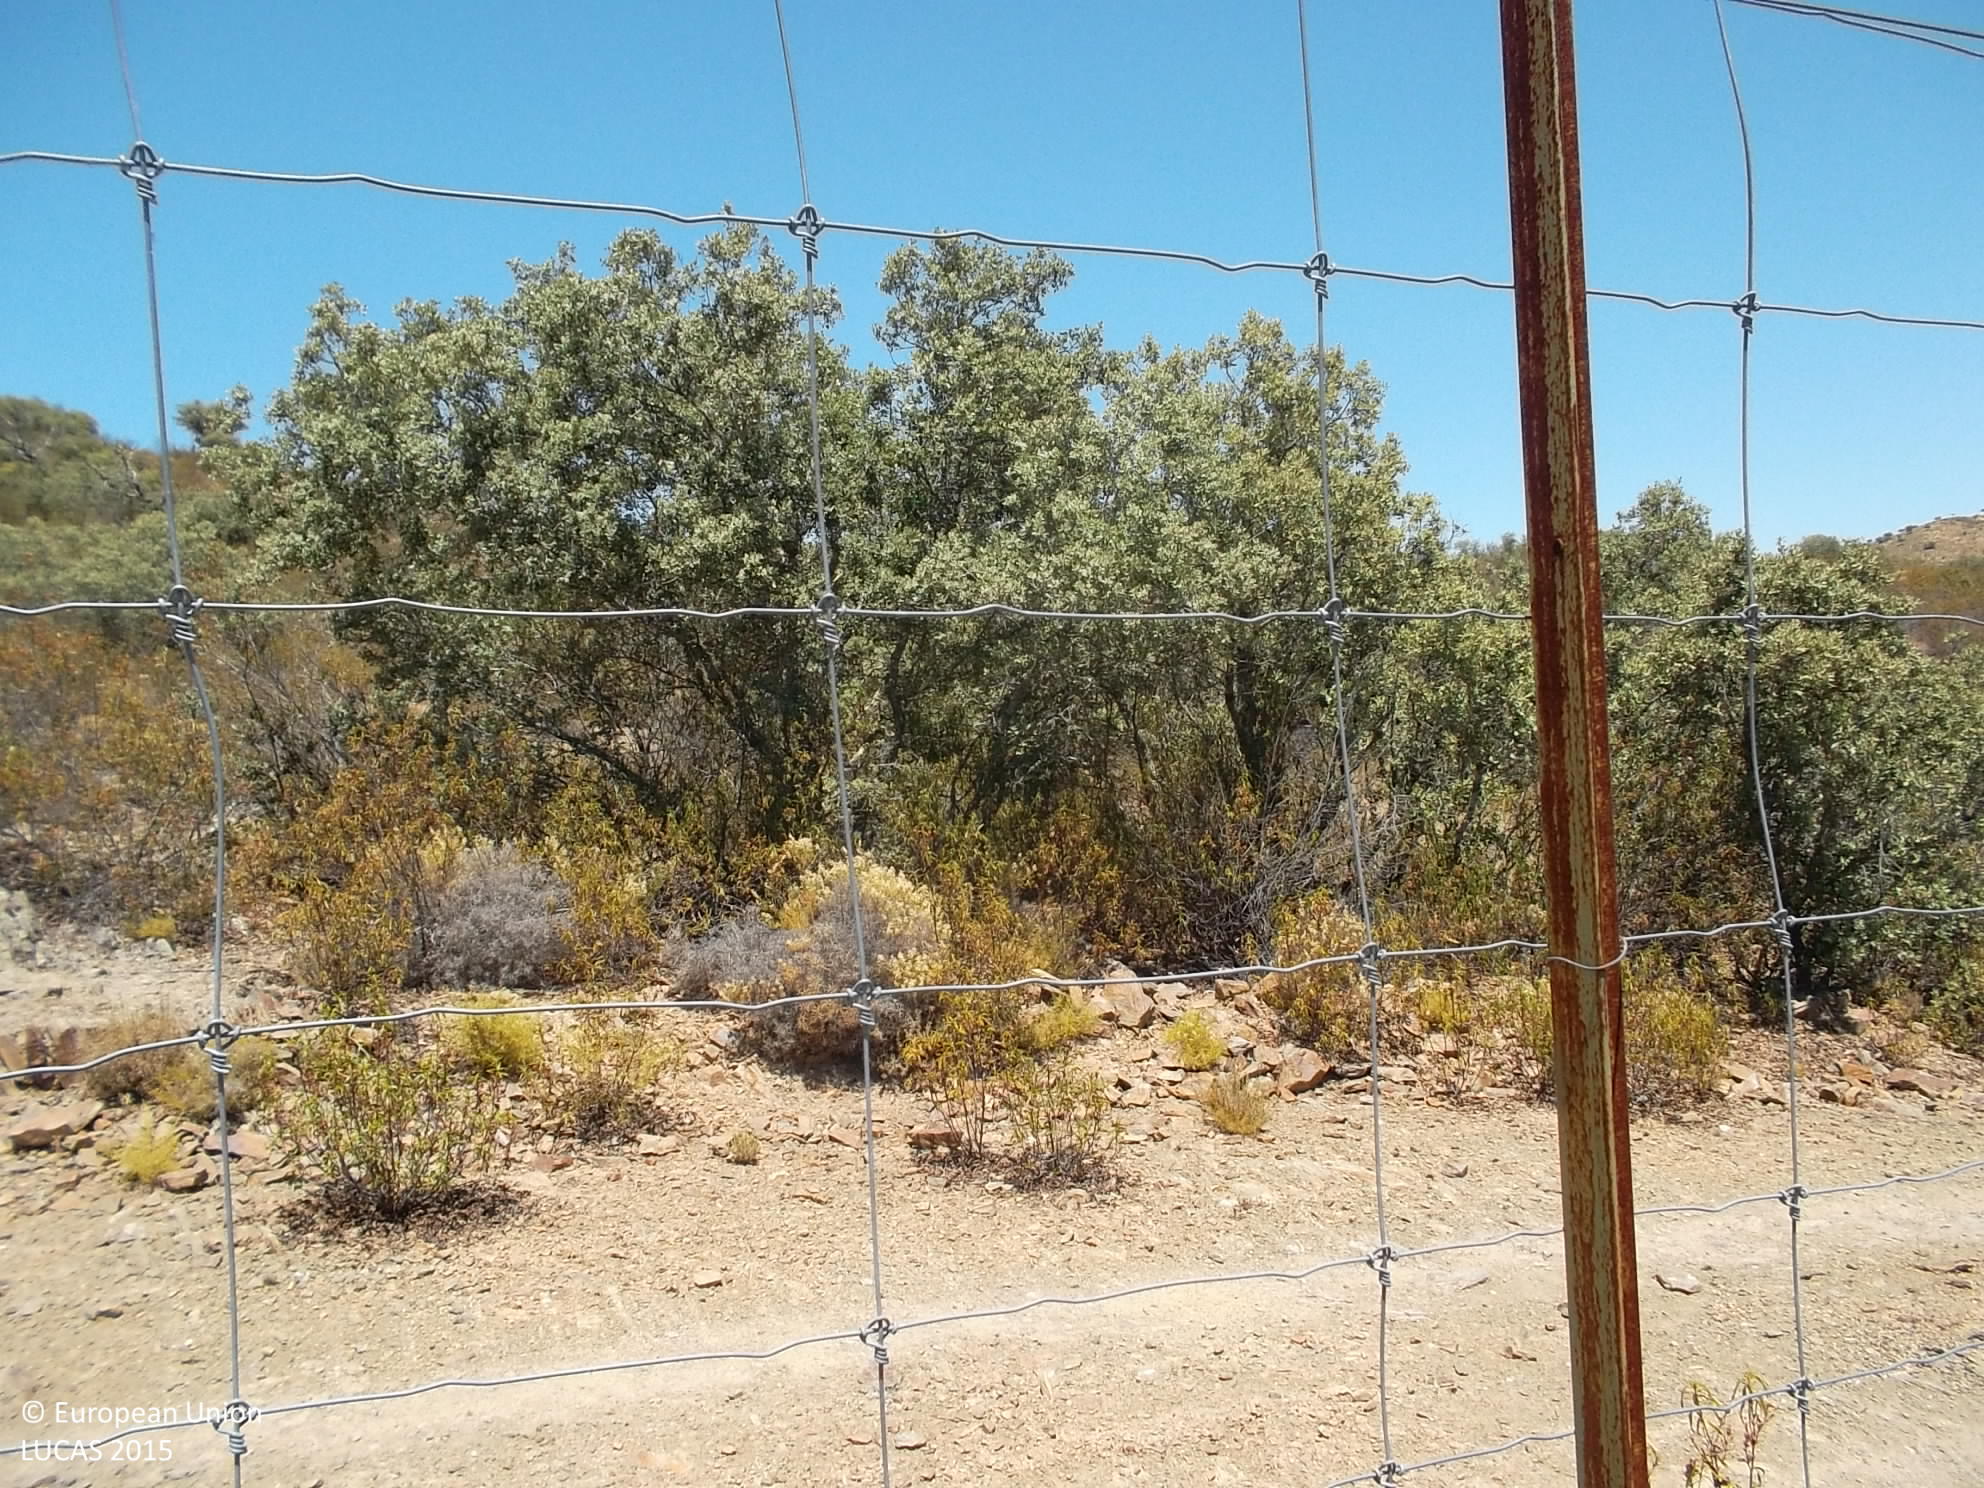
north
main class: Woodland
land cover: Broadleaved woodland
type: broadleaved evergreen forest
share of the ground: 25 - 50 %
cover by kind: shrubs 70 %, broadleaved forest trees 30 %
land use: Forestry
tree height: > 5 m
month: July
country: ES
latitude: 38.1871
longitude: -5.6859
